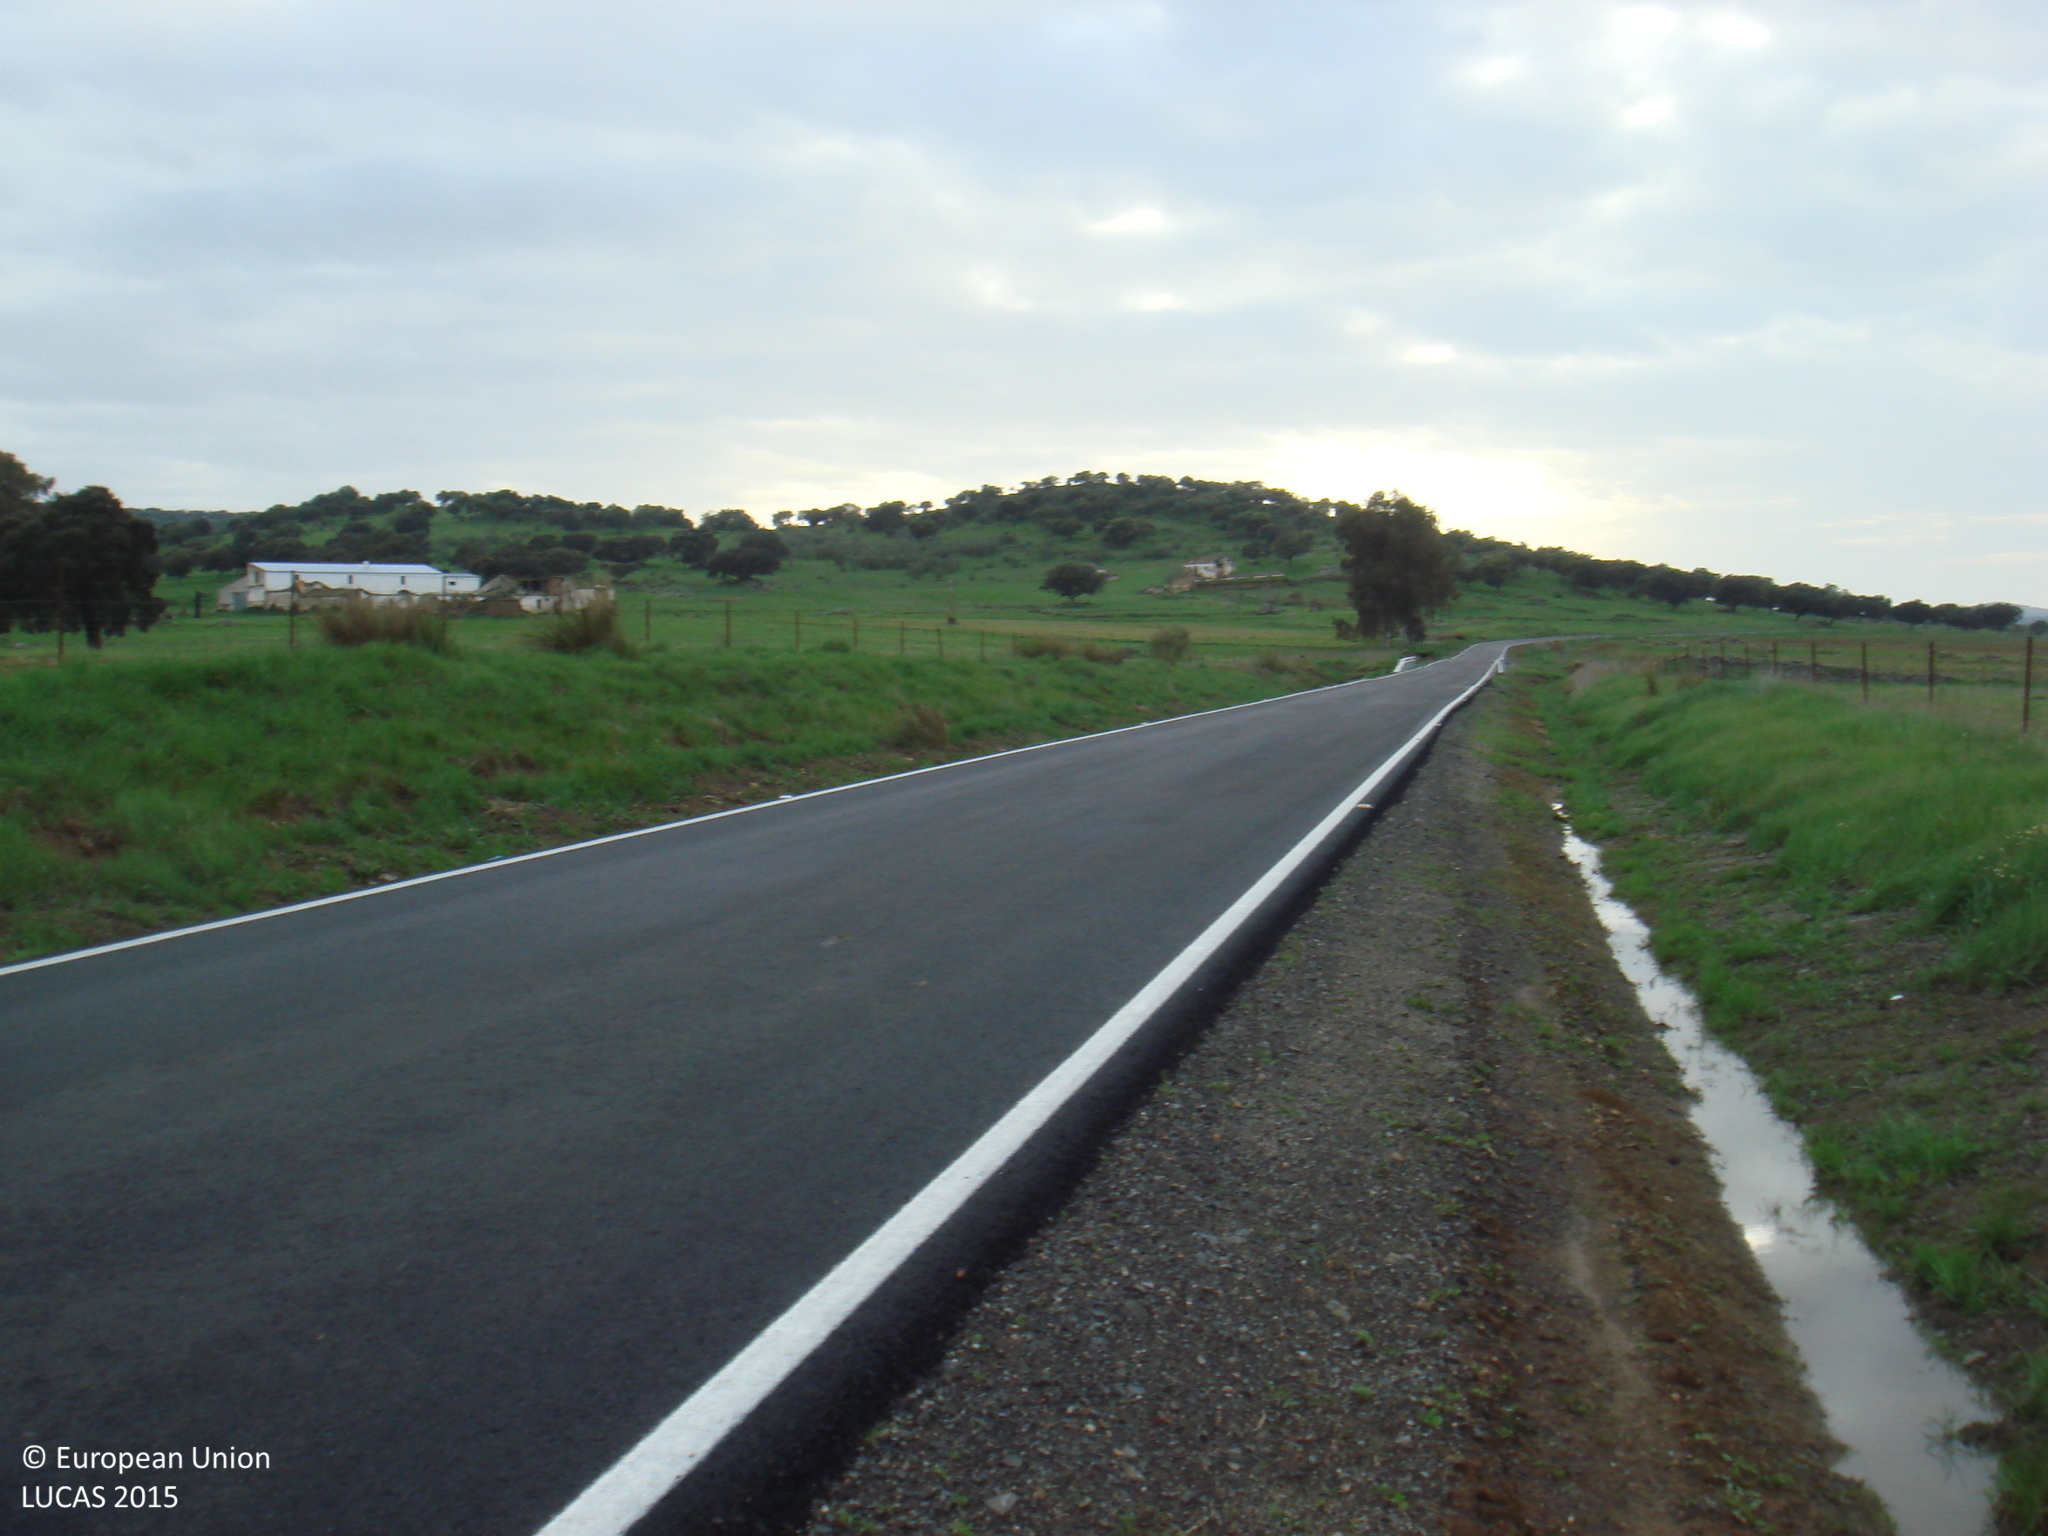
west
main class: Grassland
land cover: Grassland without tree/shrub cover
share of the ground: > 75 %
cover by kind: herbaceous plants 100 %
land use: Semi-natural and natural areas not in use
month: April
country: ES
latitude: 38.2384
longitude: -5.3729
